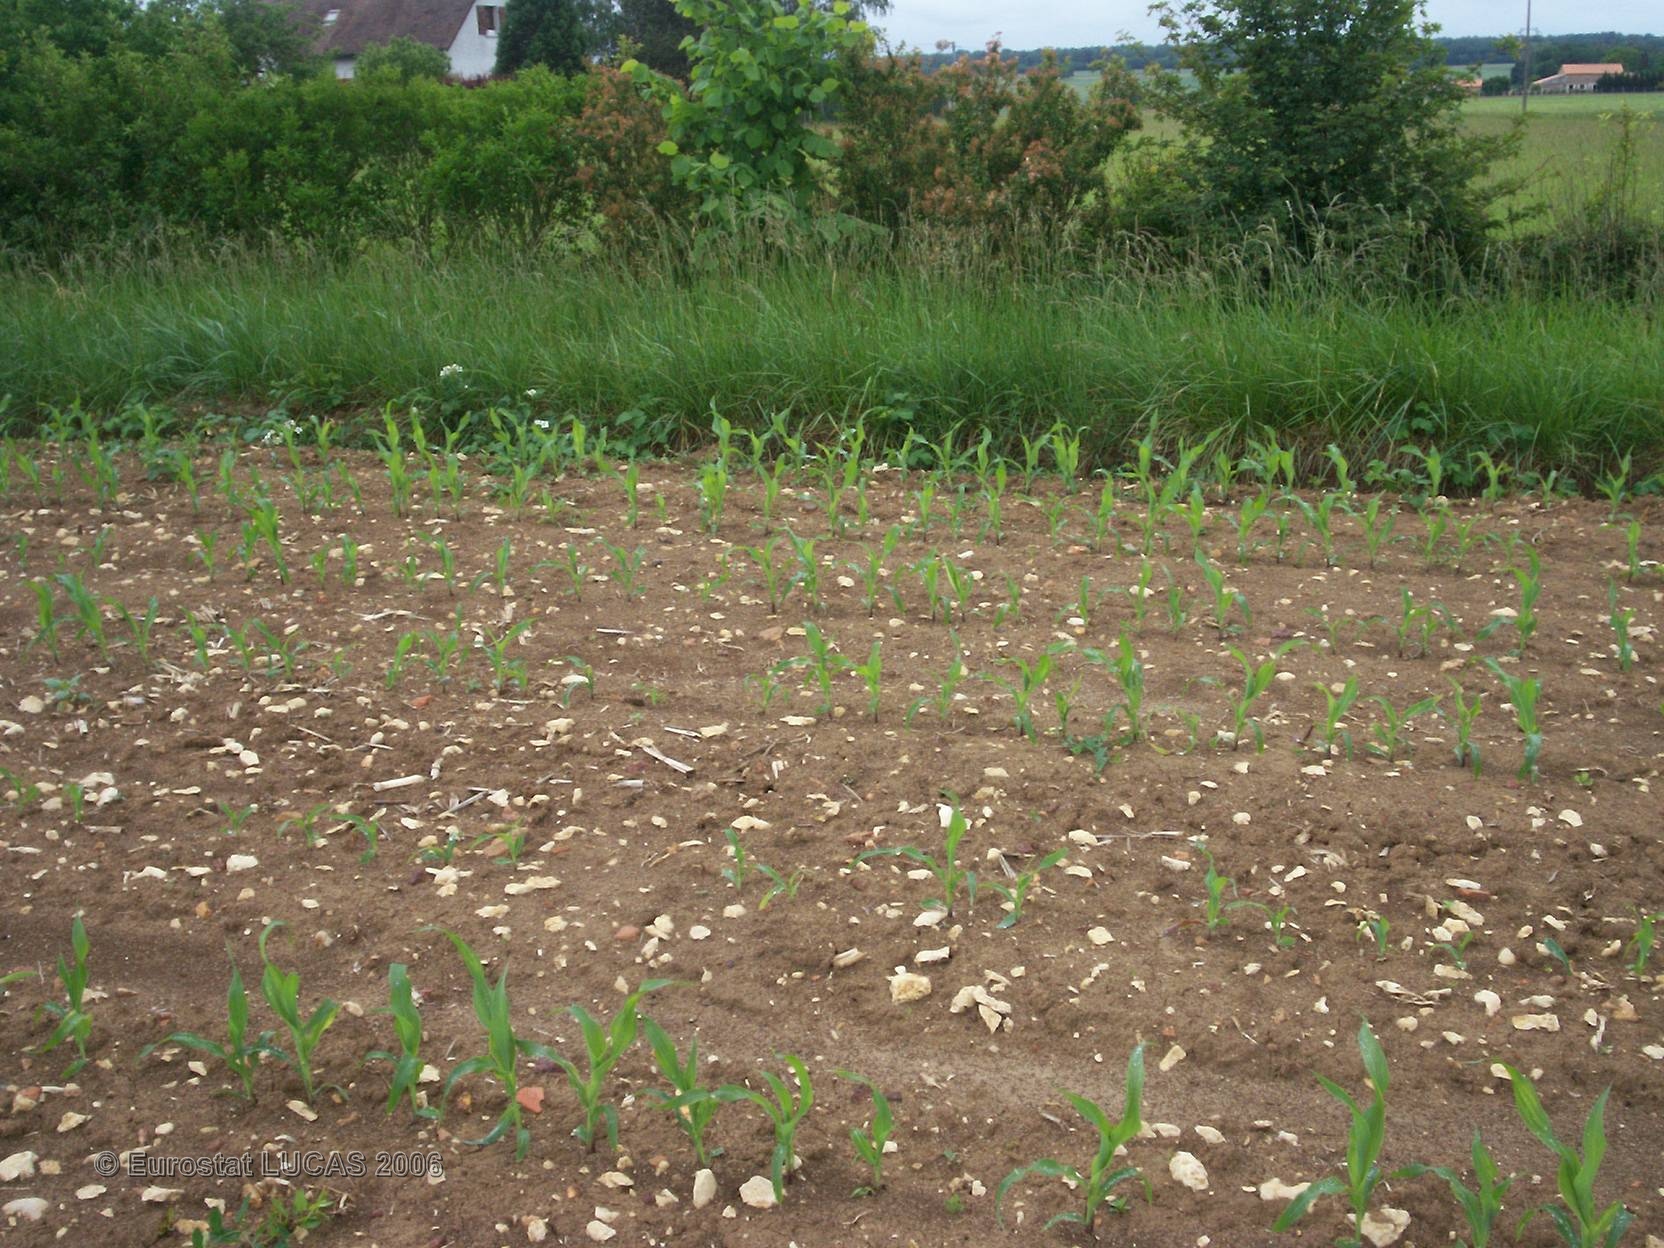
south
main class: Cropland
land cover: Maize
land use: Agriculture (excluding fallow land and kitchen gardens)
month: May
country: FR
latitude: 46.6666
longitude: 0.4533
